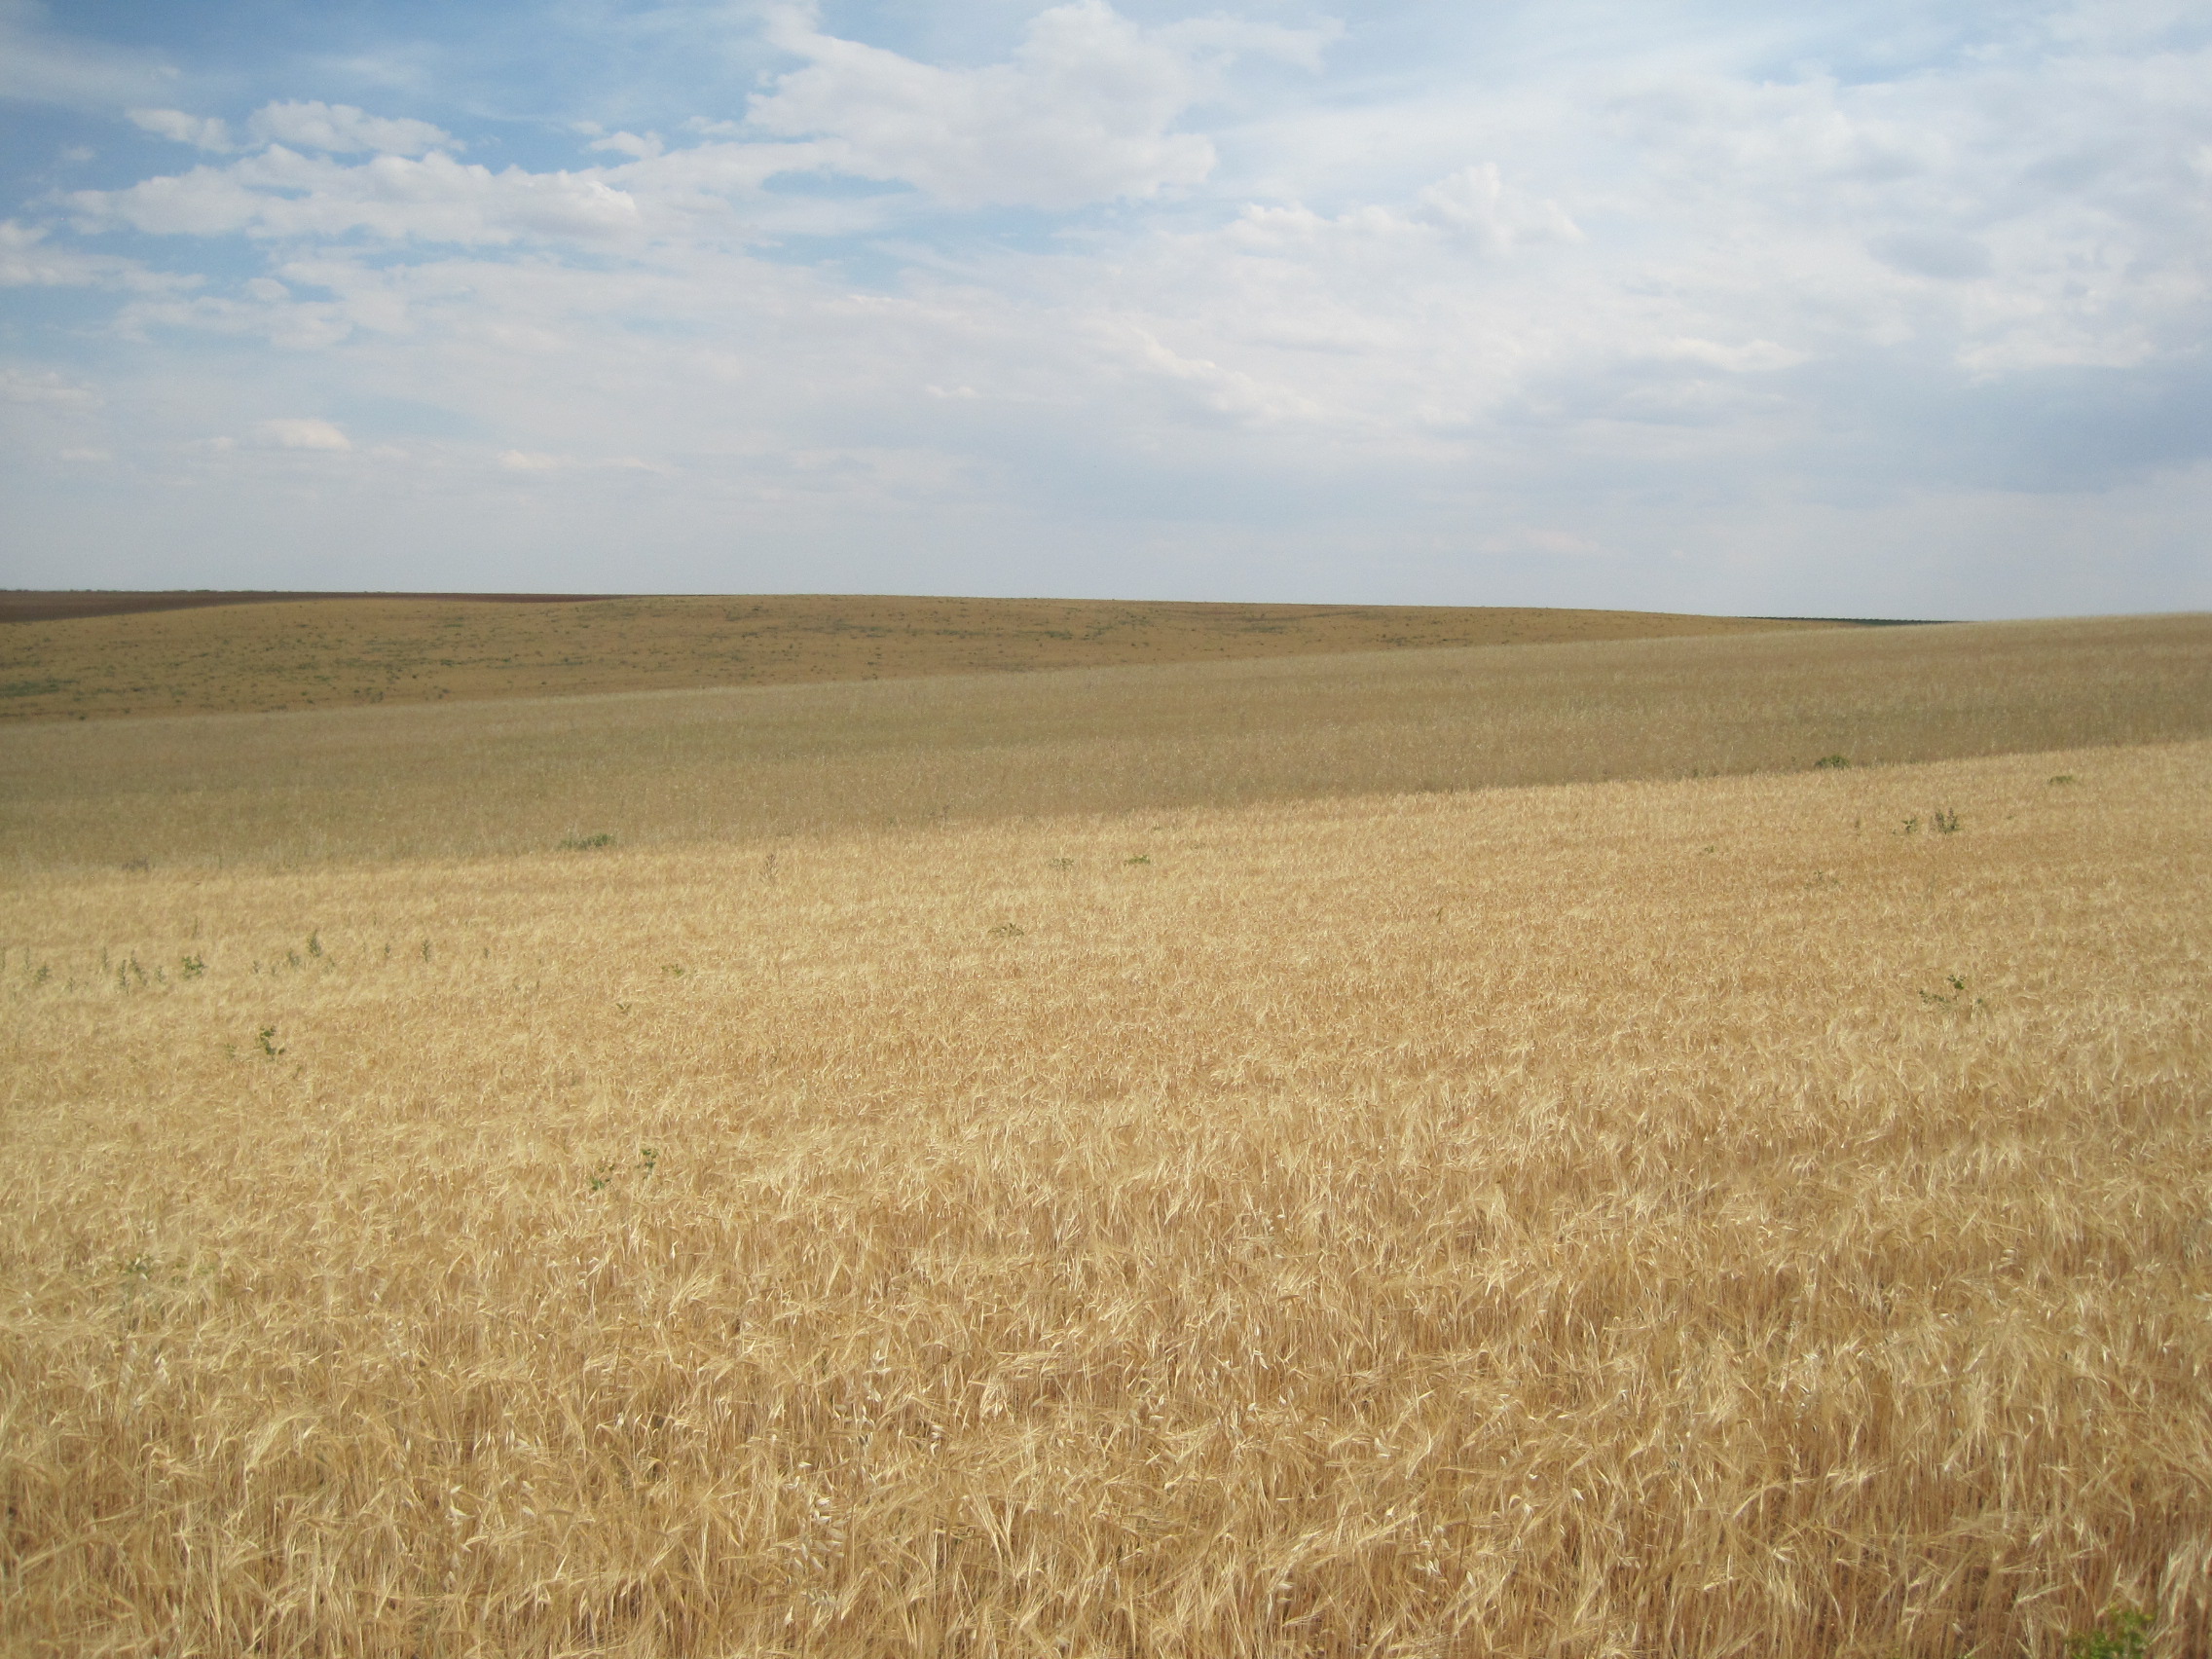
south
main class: Cropland
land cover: Barley
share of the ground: > 75 %
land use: Agriculture (excluding fallow land and kitchen gardens)
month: June
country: ES
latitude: 41.3926
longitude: -5.0572
